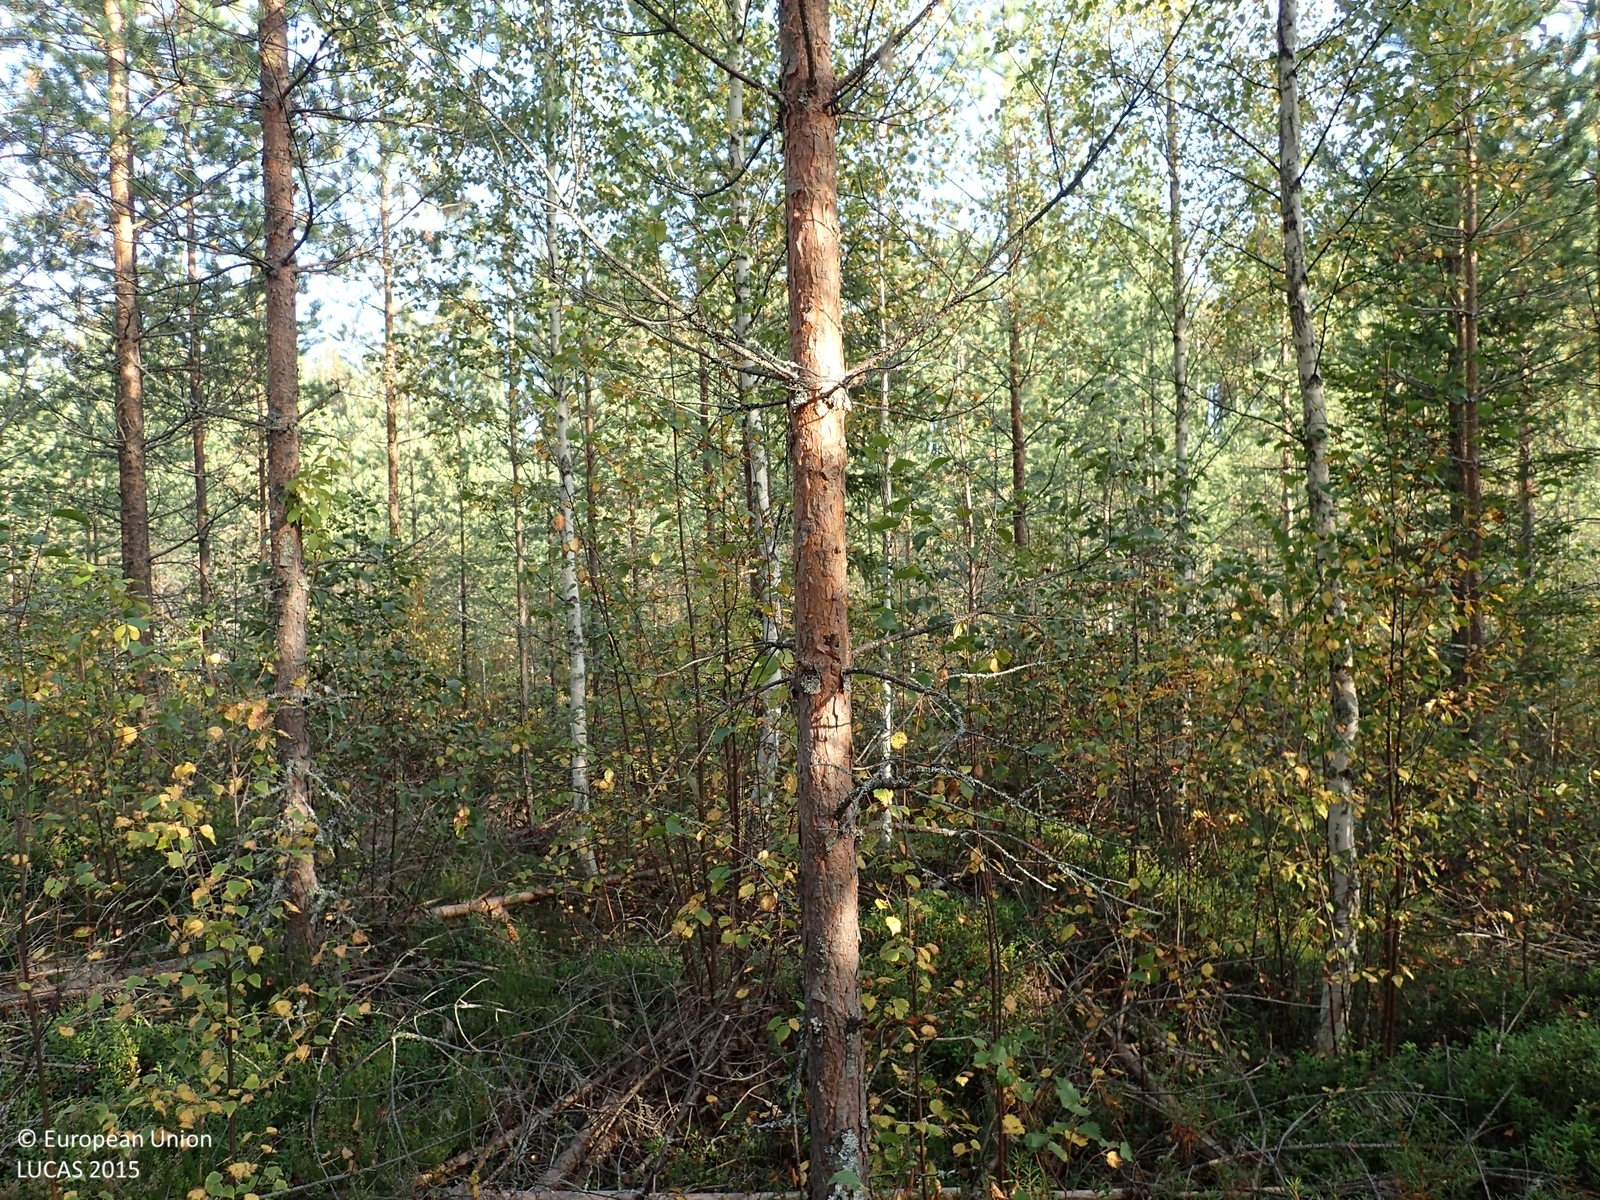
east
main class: Woodland
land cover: Pine dominated mixed woodland
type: boreal forest
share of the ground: > 75 %
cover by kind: coniferous forest trees 60 %, broadleaved forest trees 20 %, shrubs 20 %
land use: Forestry
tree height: < 5 m
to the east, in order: Pine dominated mixed woodland; Fences; Abandoned hedges; Ditches and canals; Shruby margins; Paved roads, cycling and walking lanes; Shruby margins; Ditches and canals; Pine dominated mixed woodland; Tracks; Pine dominated mixed woodland; Other mixed woodland; Ditches and canals; Spruce dominated mixed woodland; Ditches and canals; Spruce dominated mixed woodland; Ditches and canals; Temporary grasslands; Shruby margins; Ditches and canals; Spruce dominated mixed woodland; Tracks
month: September
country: FI
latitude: 63.0340
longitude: 25.5452
